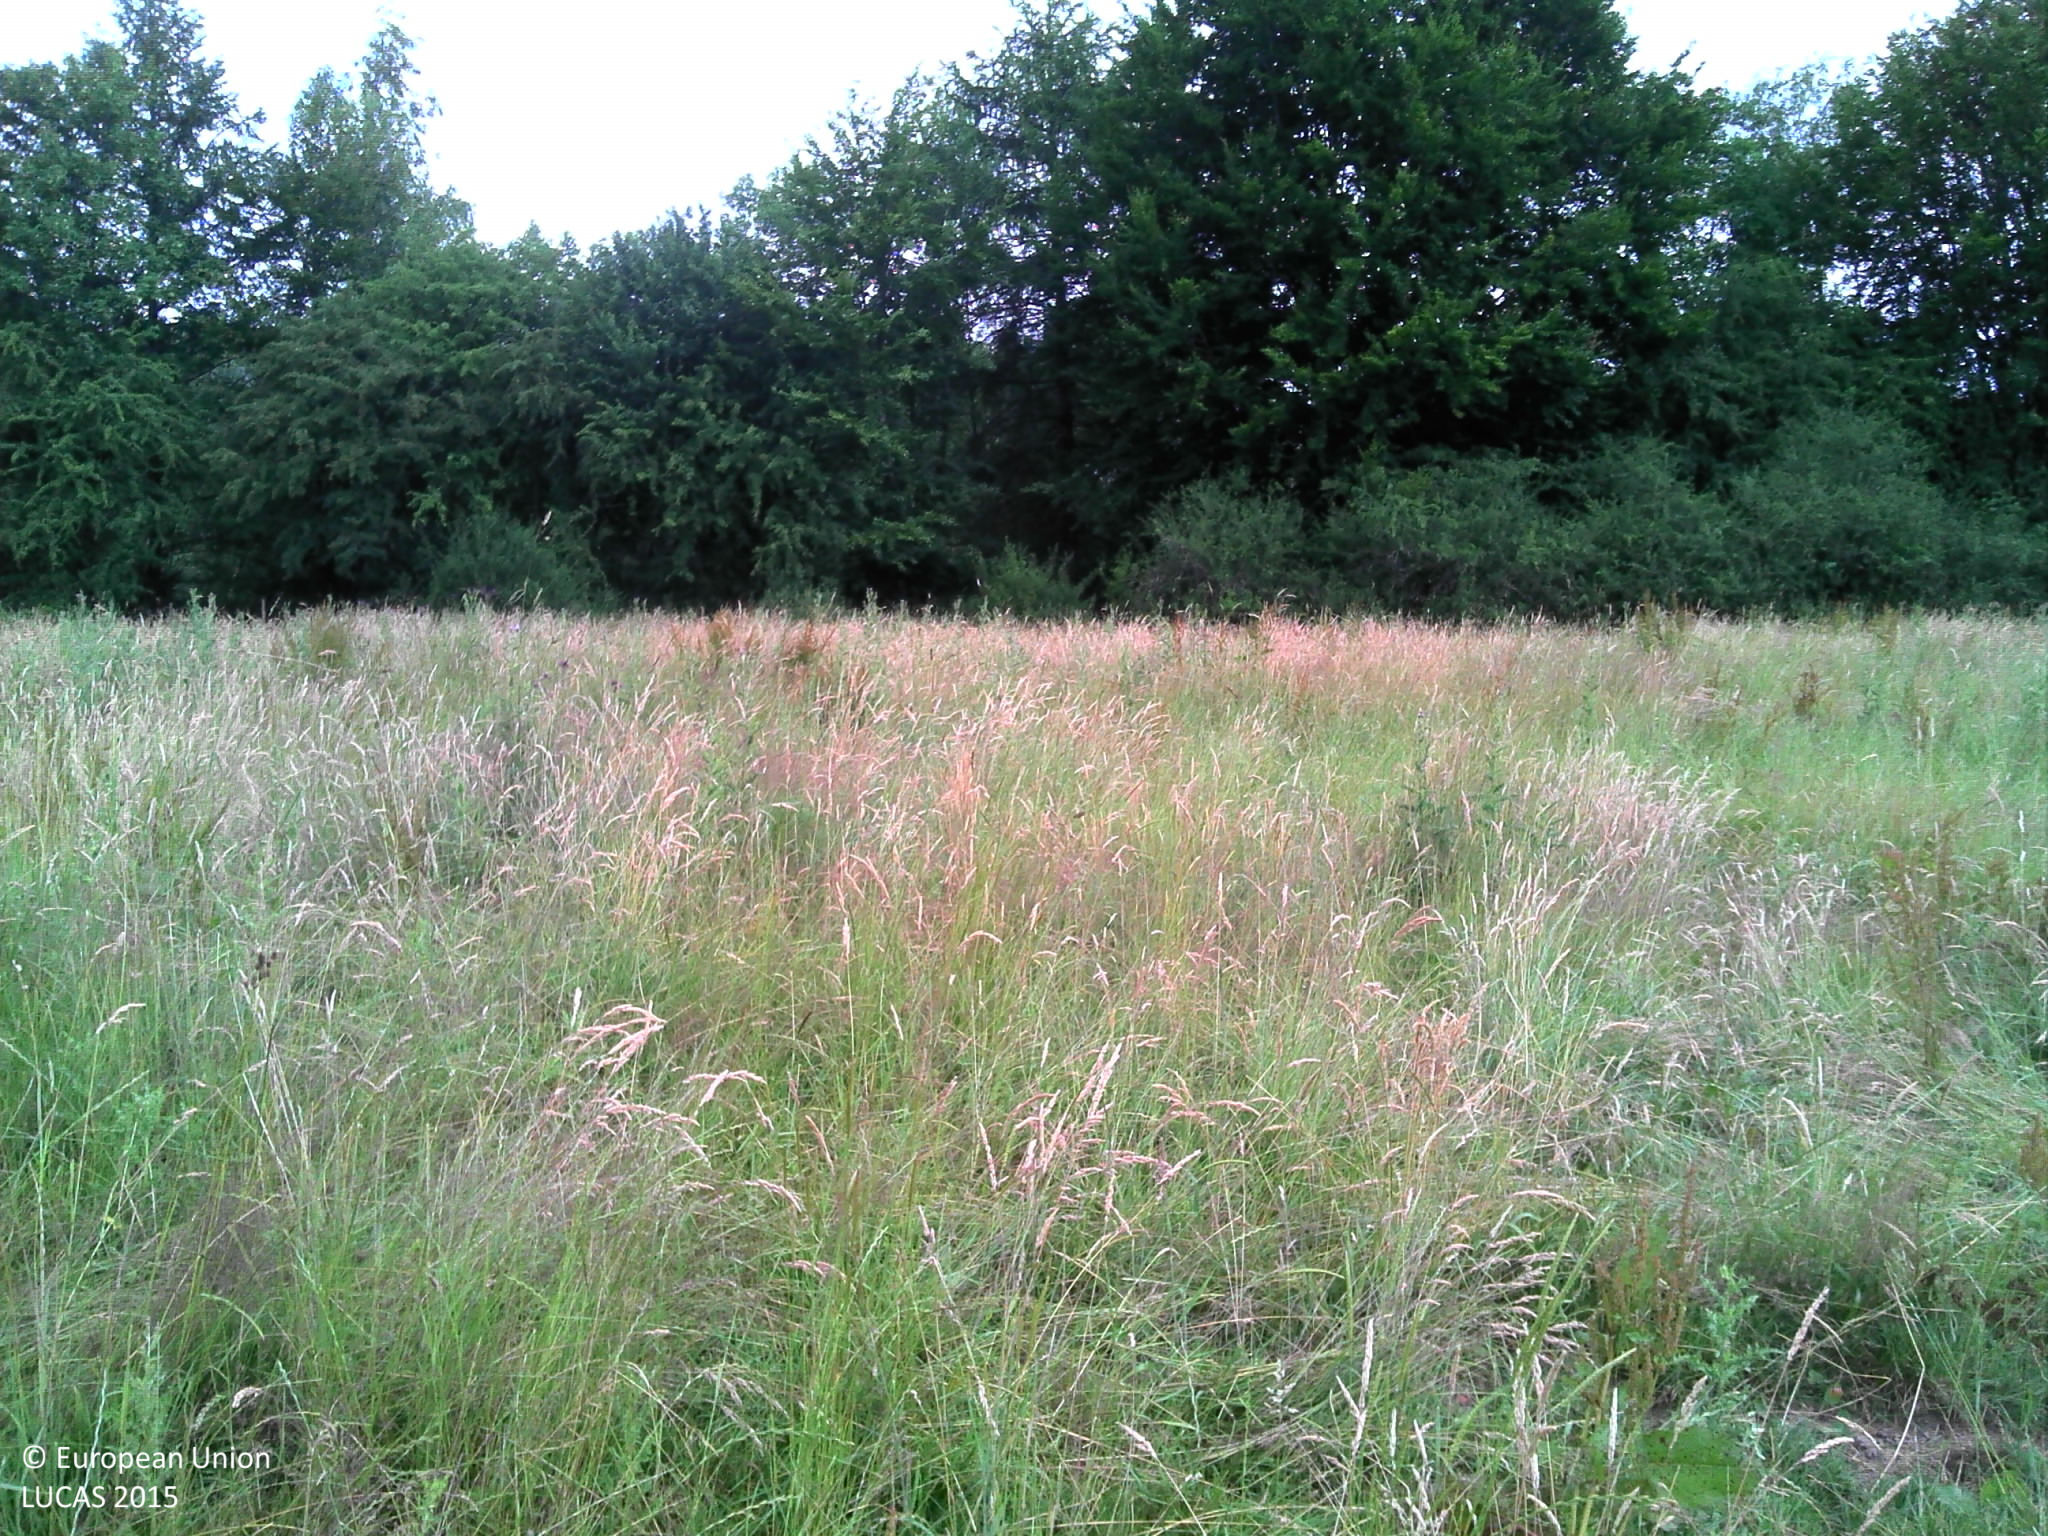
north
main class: Grassland
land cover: Grassland without tree/shrub cover
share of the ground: > 75 %
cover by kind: herbaceous plants 100 %
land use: Agriculture (excluding fallow land and kitchen gardens)
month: July
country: BE
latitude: 49.8681
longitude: 5.2257
